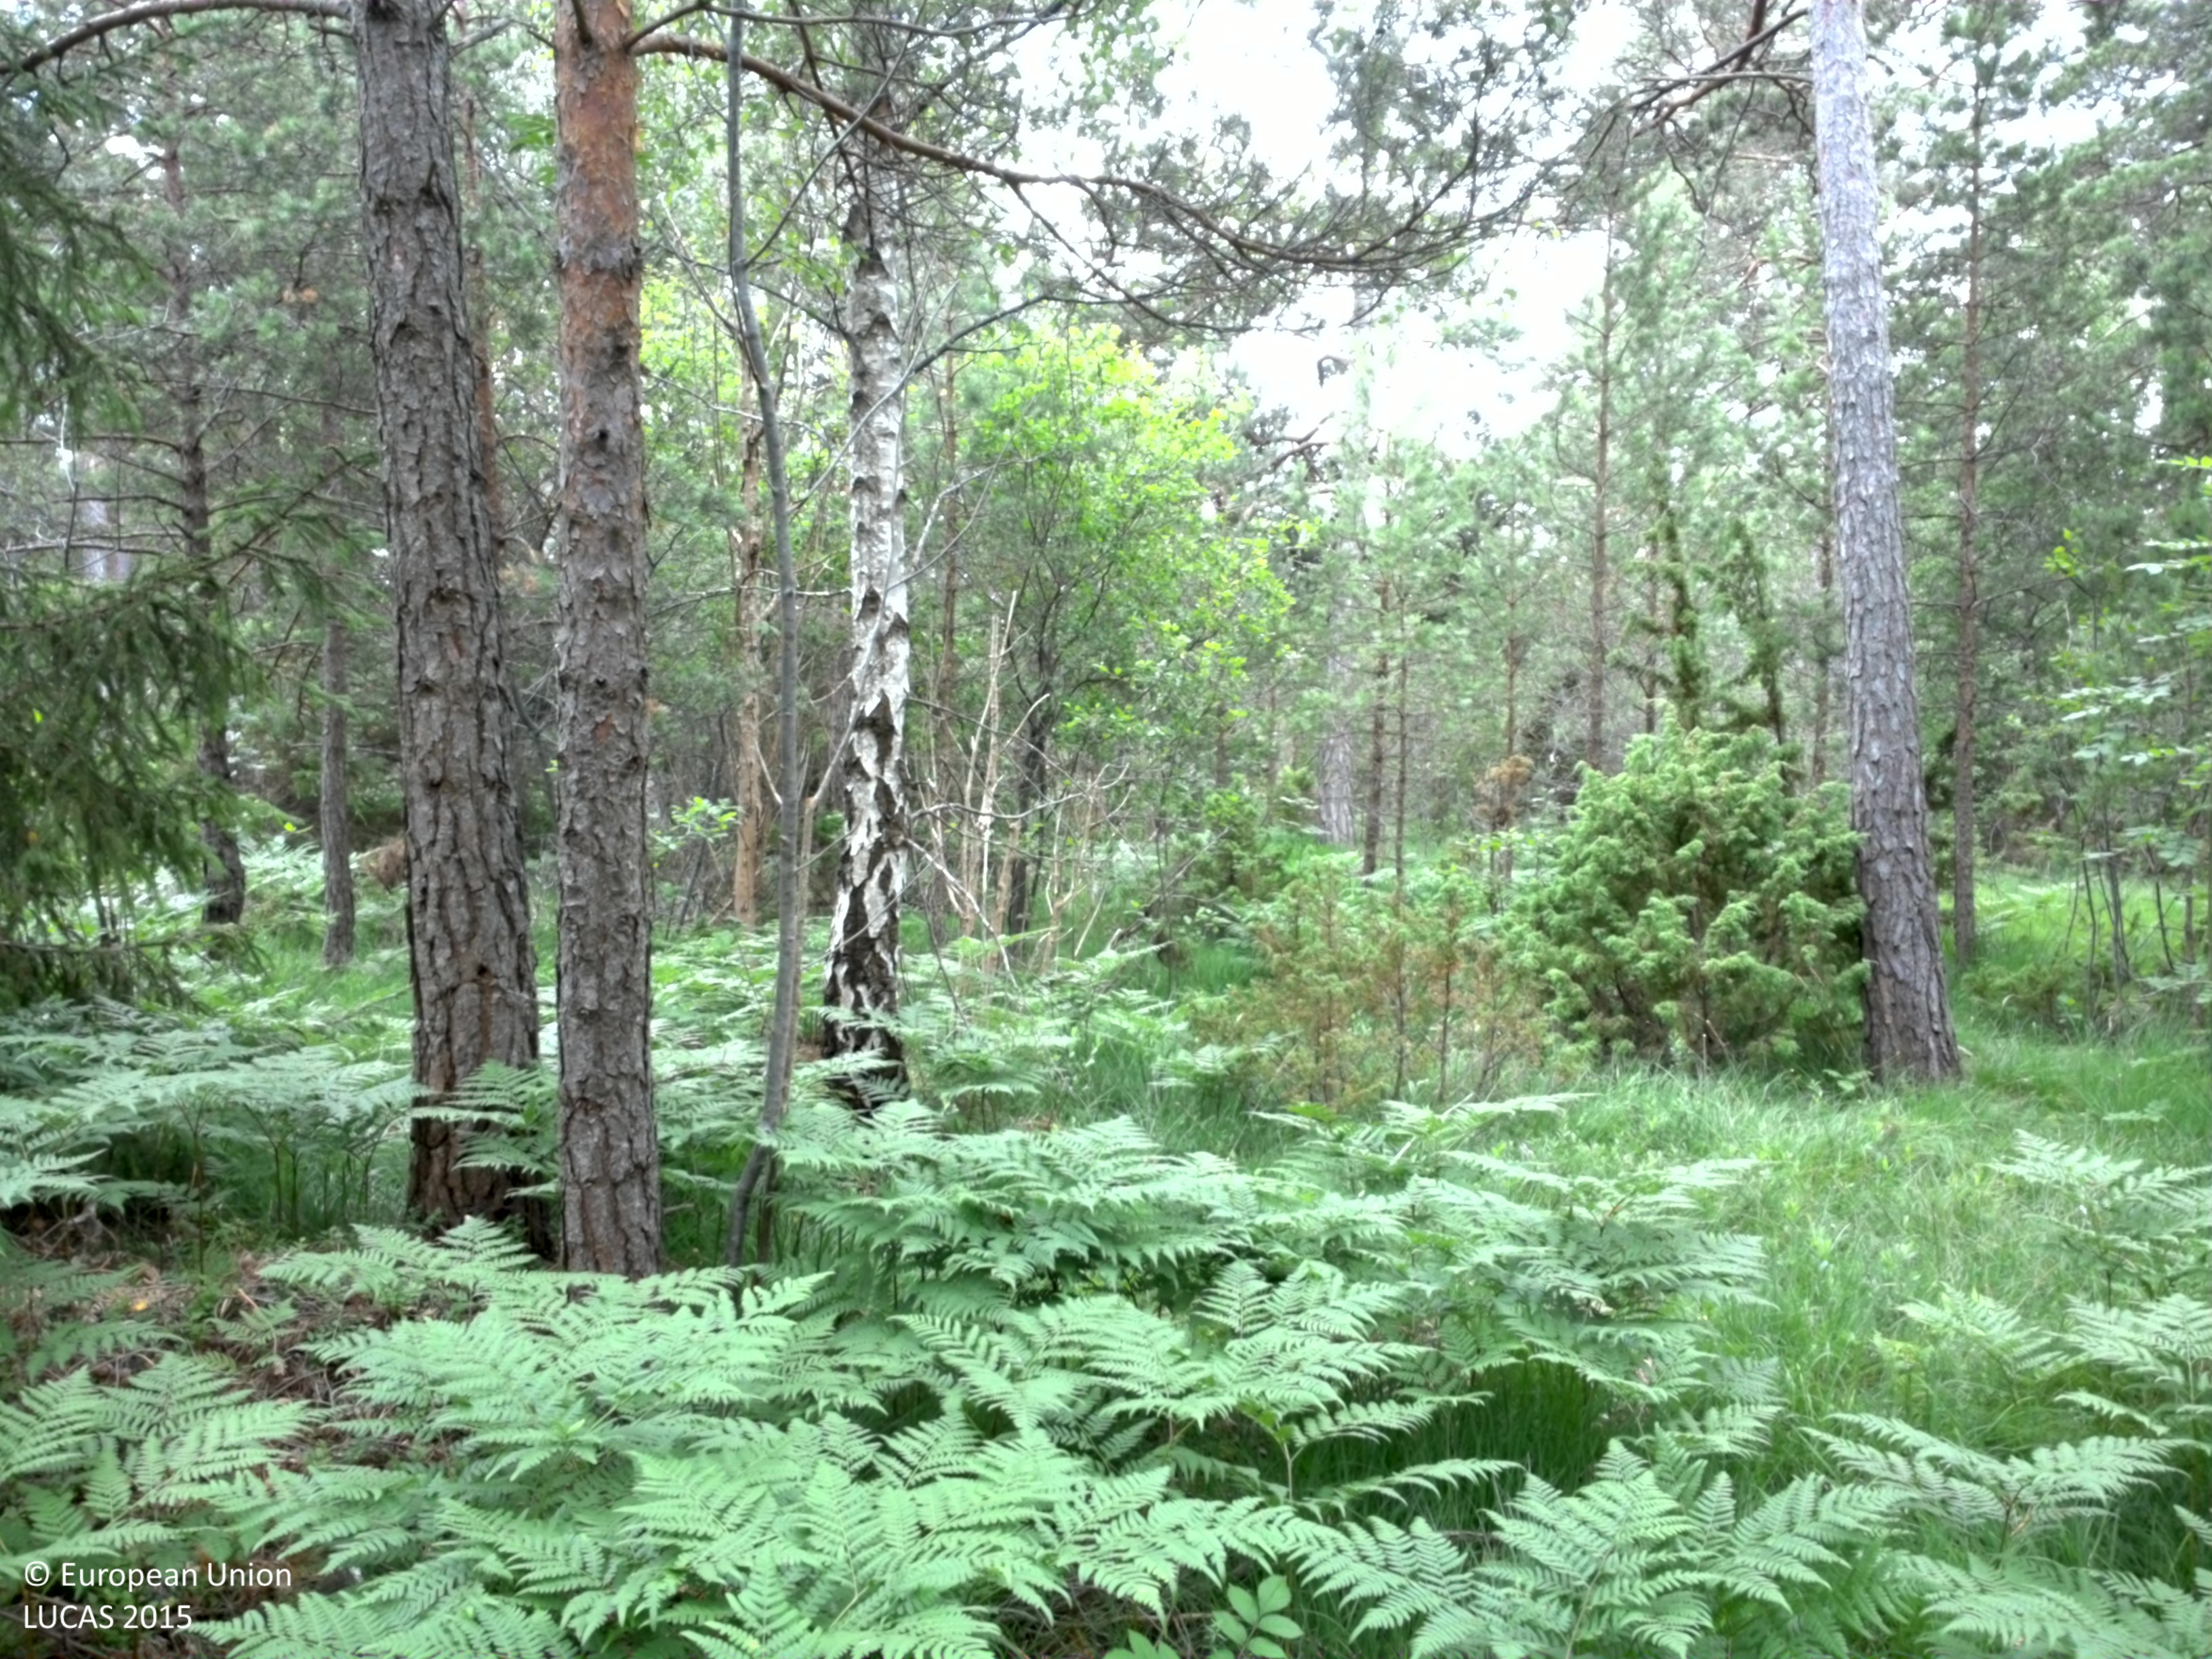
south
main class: Woodland
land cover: Pine dominated coniferous woodland
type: hemiboreal forest and nemoral coniferous forest and mixed broadleaved-coniferous forest
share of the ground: > 75 %
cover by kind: coniferous forest trees 75 %, herbaceous plants 15 %, broadleaved forest trees 5 %, shrubs 5 %
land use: Forestry
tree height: > 5 m
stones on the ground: < 10 %
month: July
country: SE
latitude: 57.3852
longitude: 18.2752
